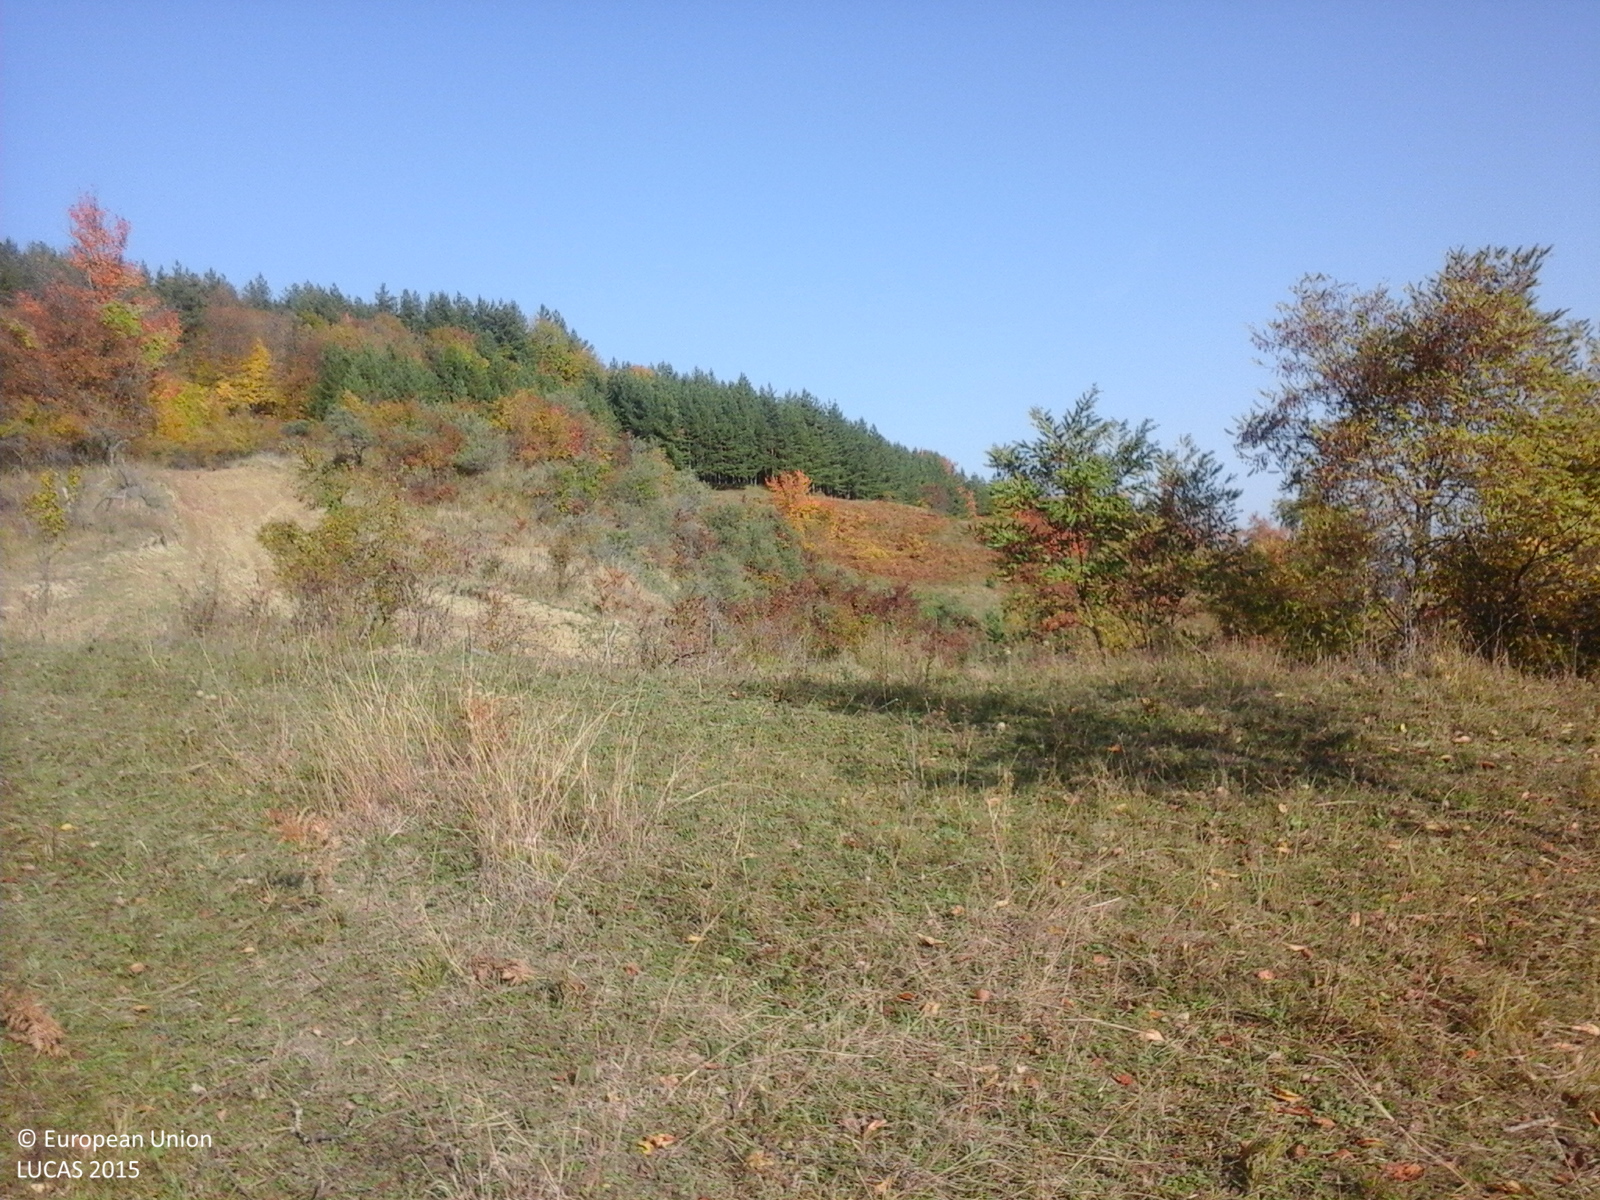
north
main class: Cropland
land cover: Other fruit trees and berries
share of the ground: > 75 %
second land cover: Grassland without tree/shrub cover
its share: > 75 %
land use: Agriculture (excluding fallow land and kitchen gardens)
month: October
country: RO
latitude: 45.8130
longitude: 26.7227
